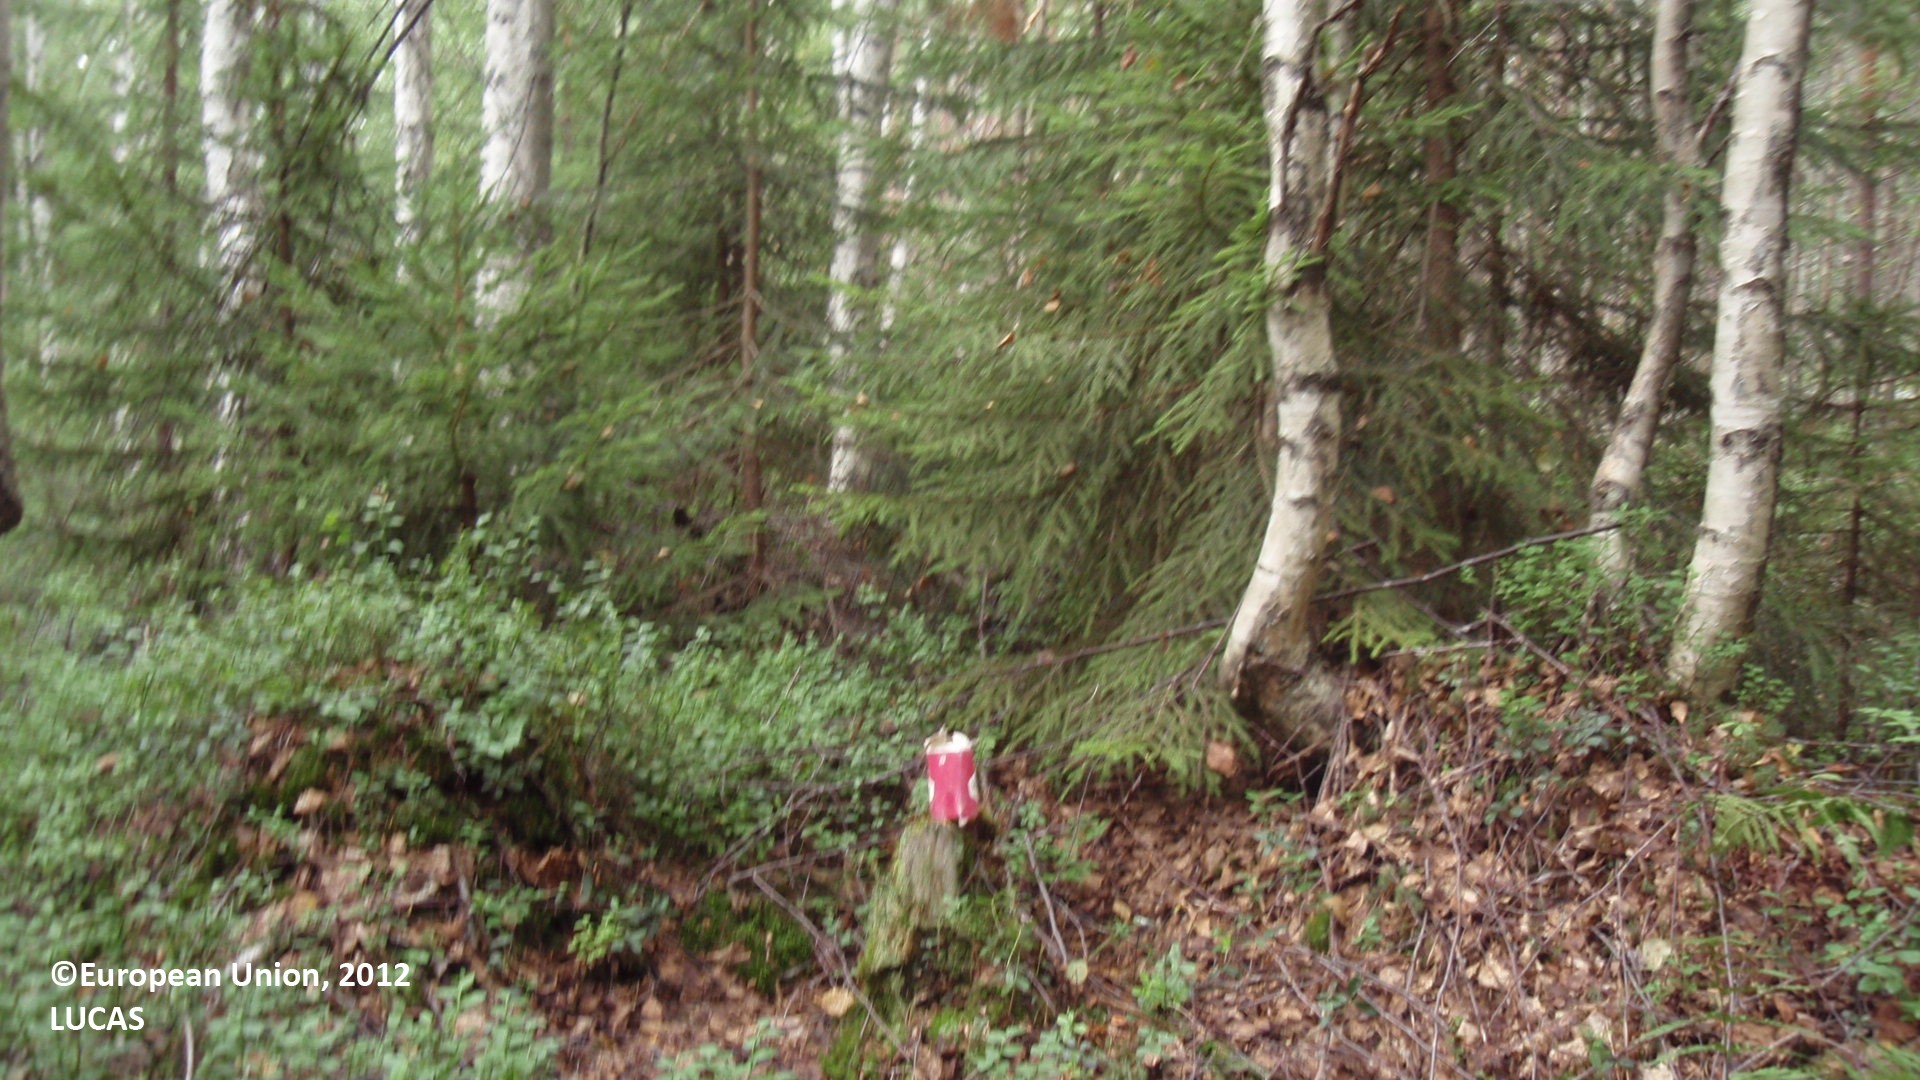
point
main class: Woodland
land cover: Pine dominated mixed woodland
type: boreal forest
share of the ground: > 75 %
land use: Forestry
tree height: > 5 m
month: August
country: FI
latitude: 60.9328
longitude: 27.5858
